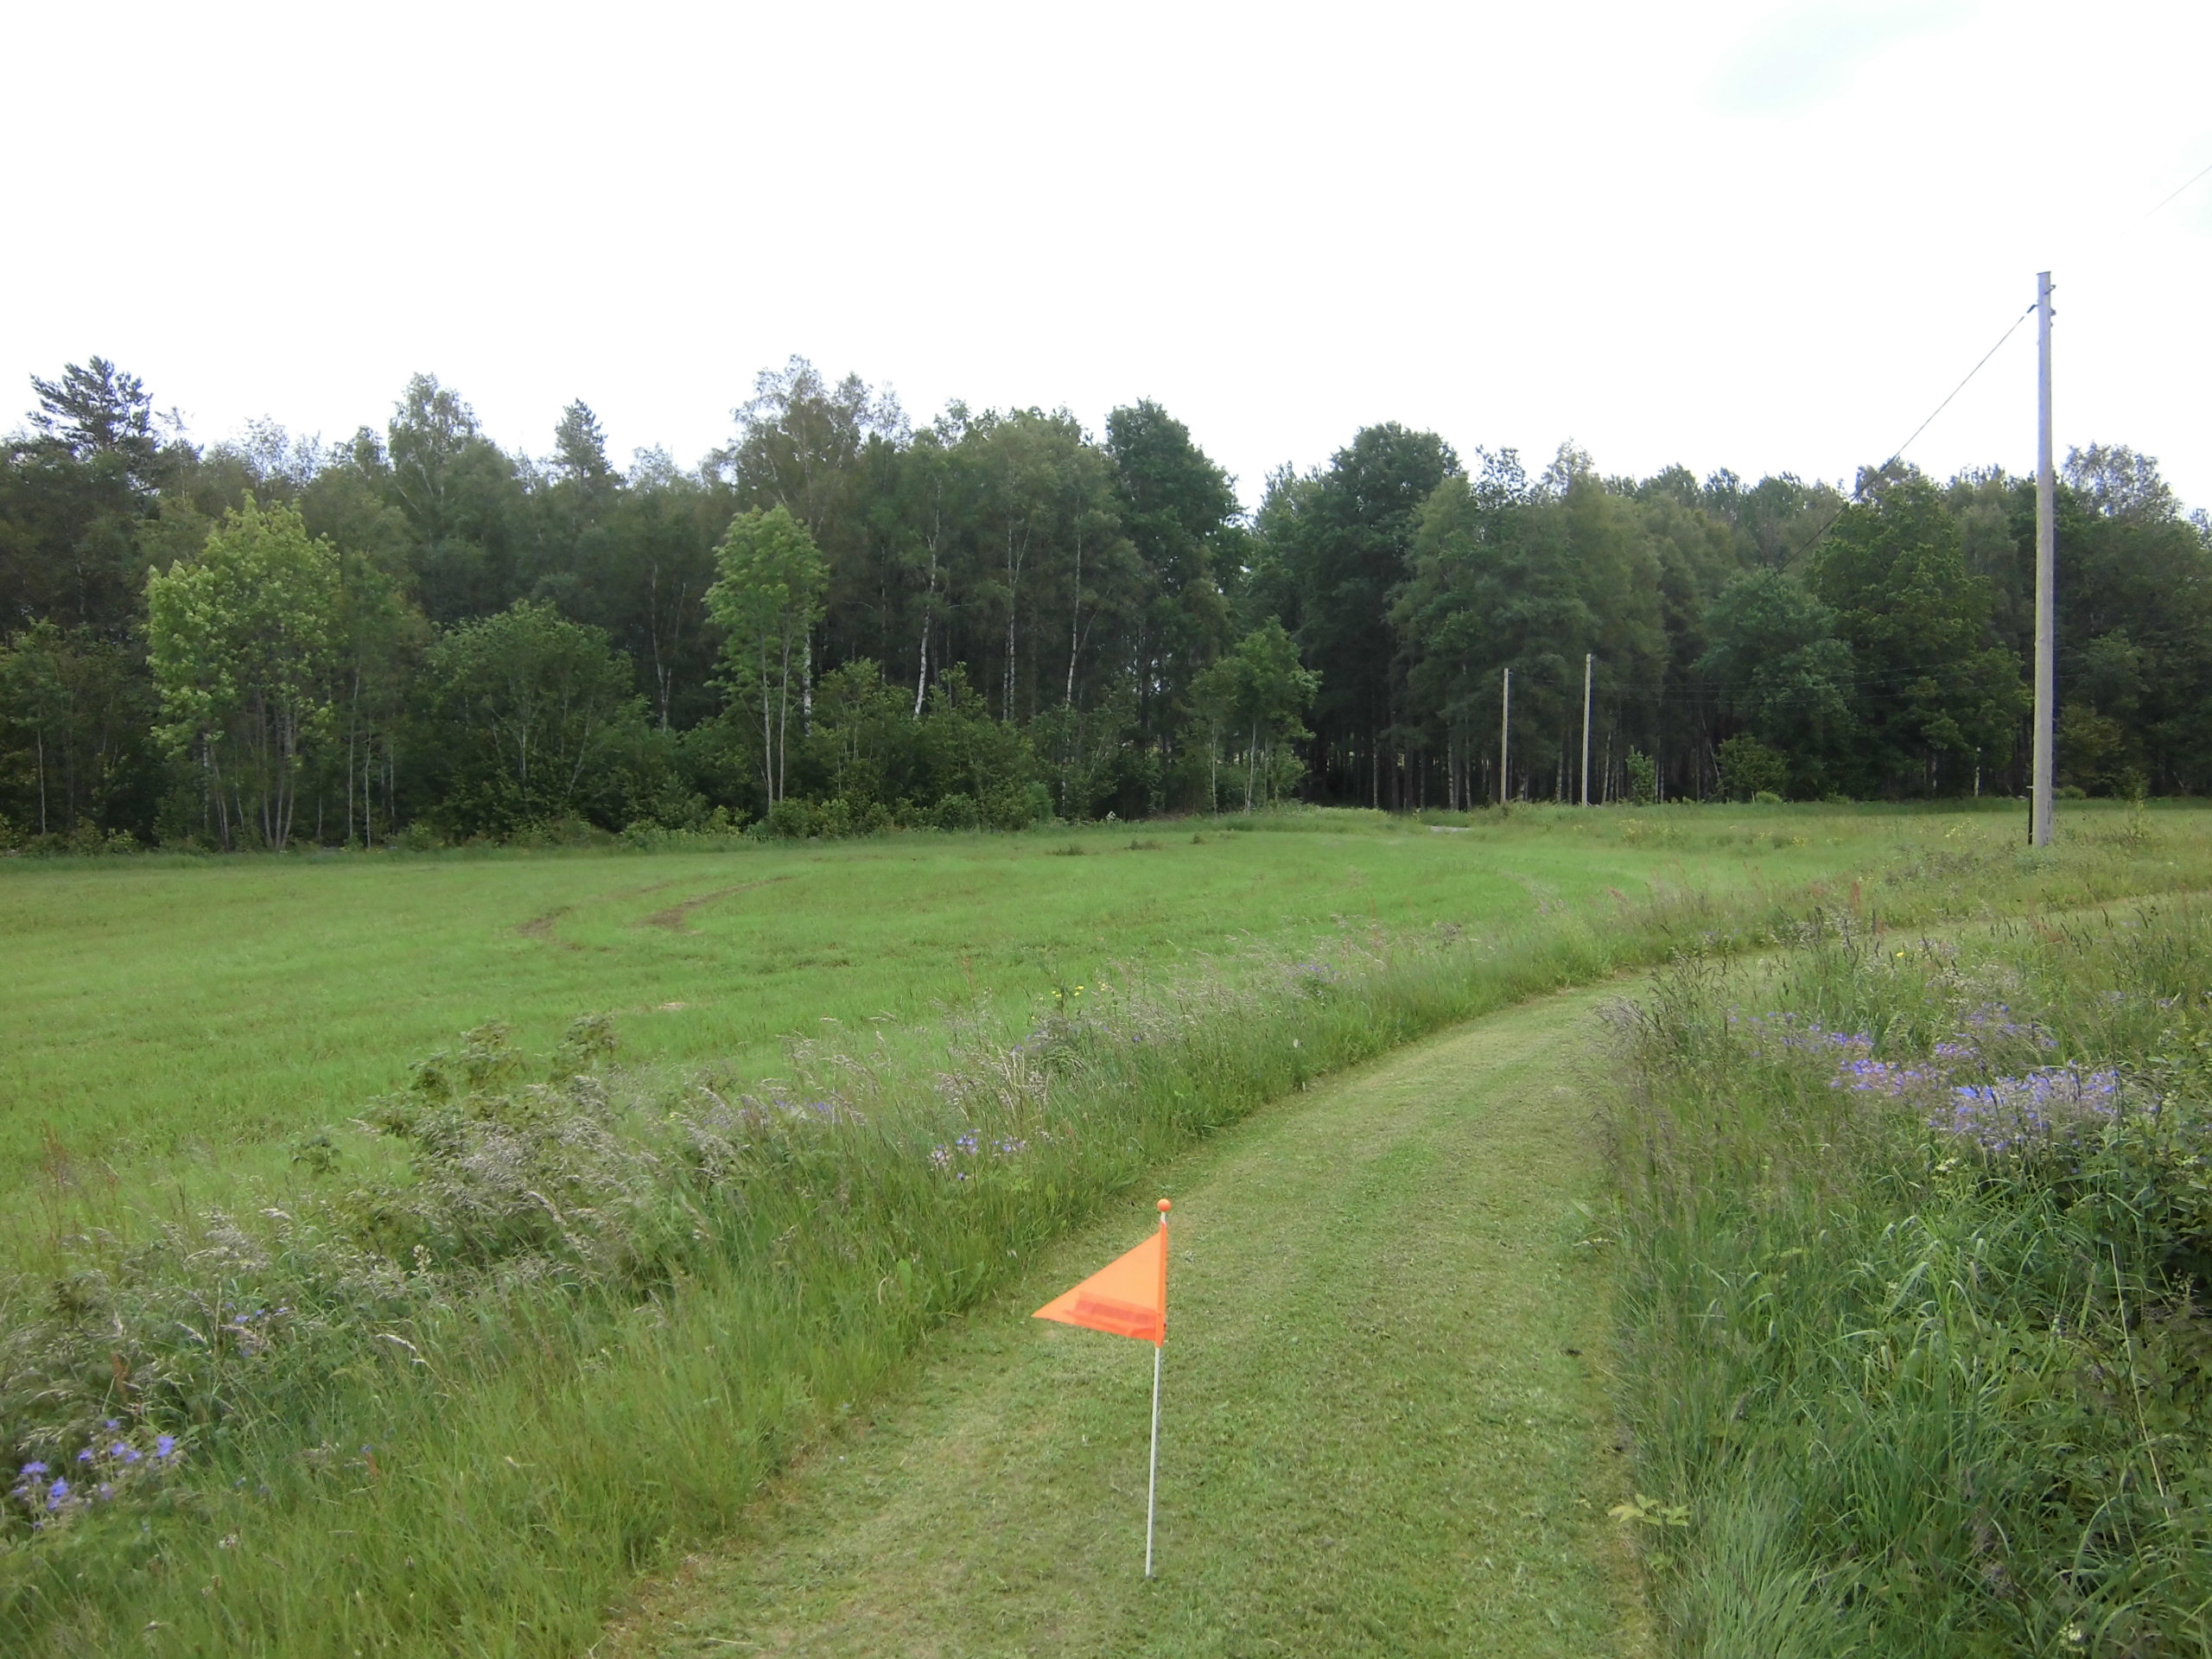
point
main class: Grassland
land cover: Grassland without tree/shrub cover
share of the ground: > 75 %
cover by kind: herbaceous plants 100 %
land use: Agriculture (excluding fallow land and kitchen gardens)
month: June
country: SE
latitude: 57.0409
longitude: 14.6278
